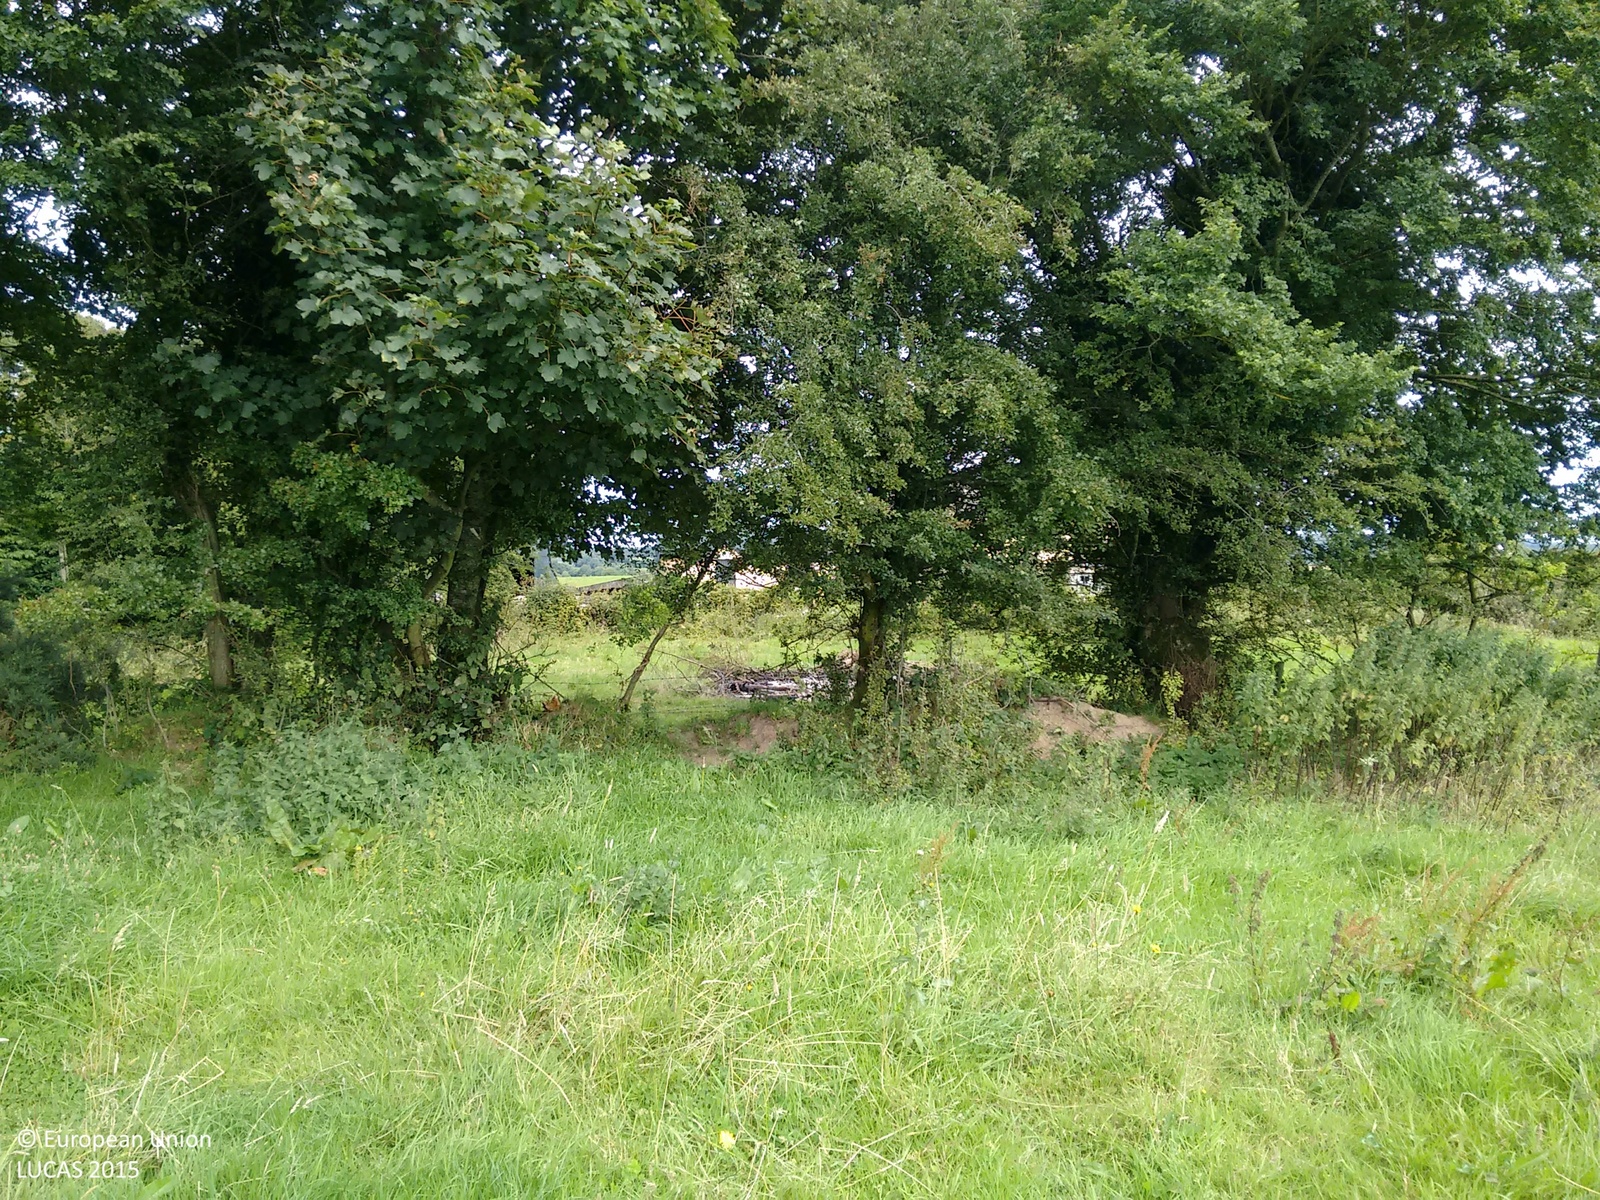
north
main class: Grassland
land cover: Grassland without tree/shrub cover
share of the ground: > 75 %
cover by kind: herbaceous plants 100 %
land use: Agriculture (excluding fallow land and kitchen gardens)
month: August
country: IE
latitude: 53.0295
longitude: -7.5306
